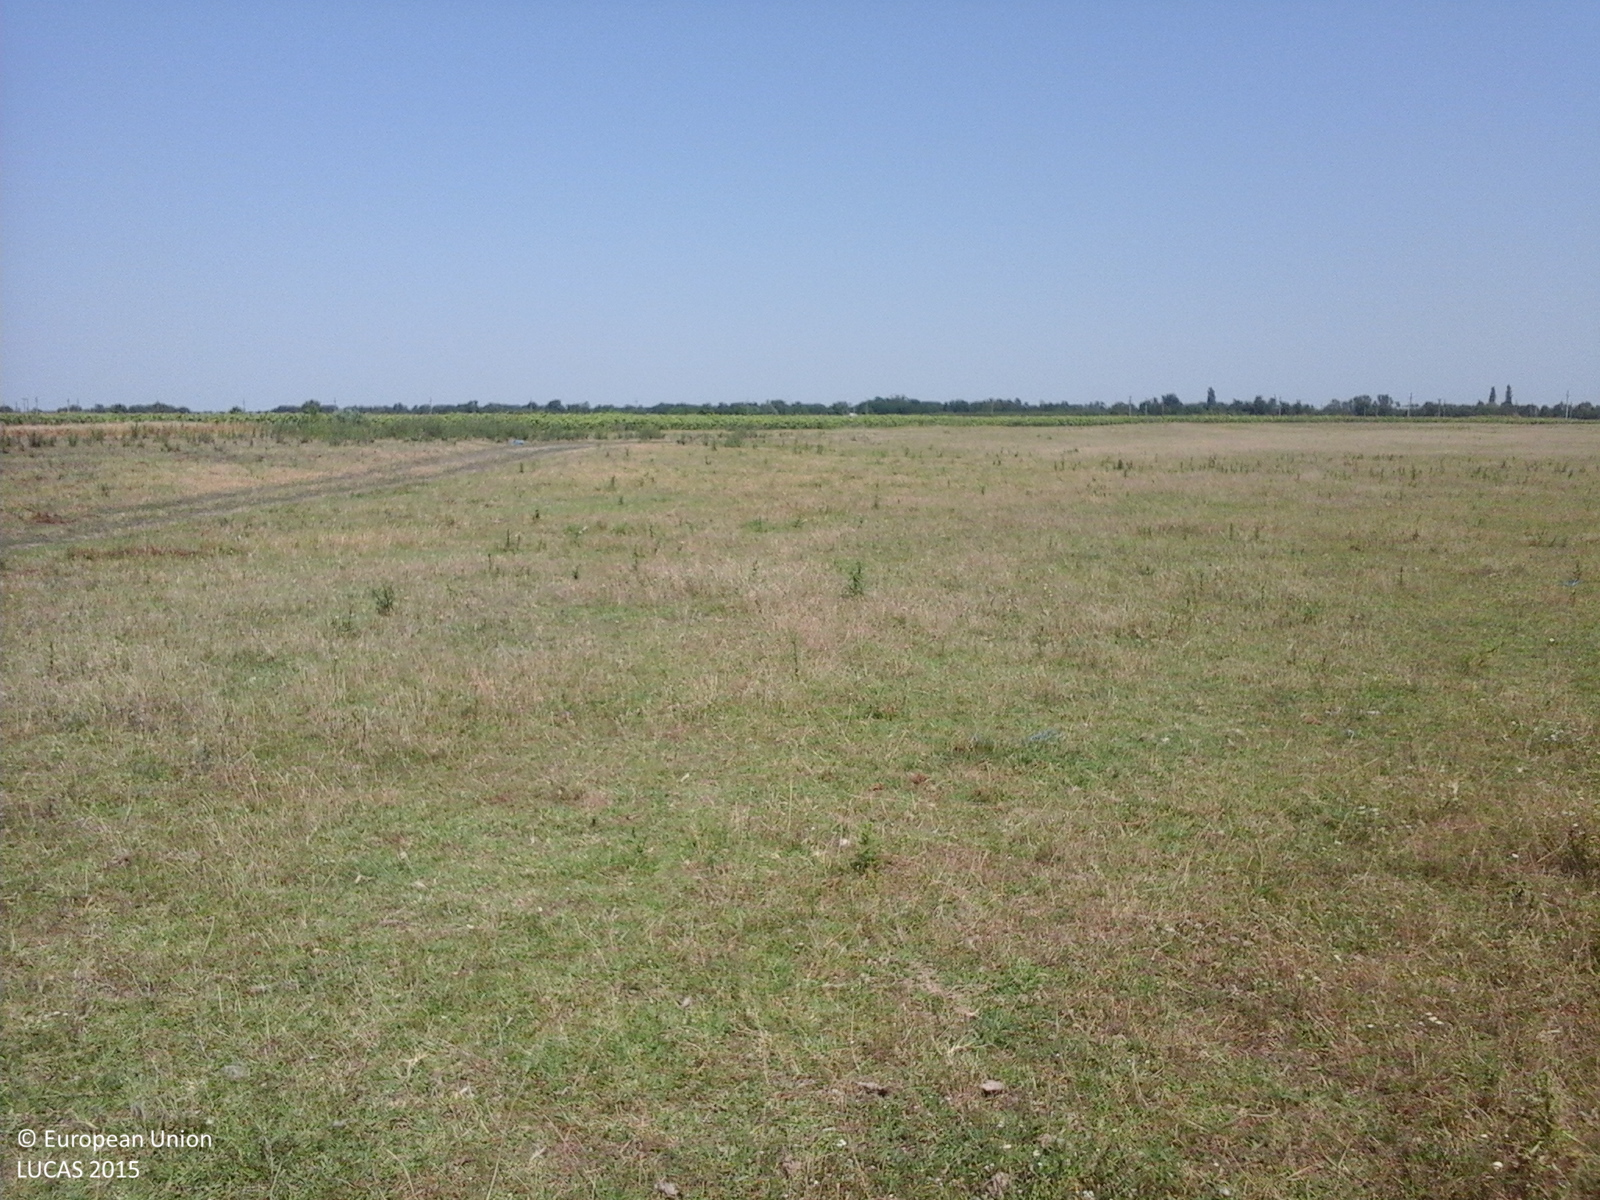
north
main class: Grassland
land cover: Grassland without tree/shrub cover
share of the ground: > 75 %
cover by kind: herbaceous plants 100 %
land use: Agriculture (excluding fallow land and kitchen gardens)
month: July
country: RO
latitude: 44.7292
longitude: 26.8317
